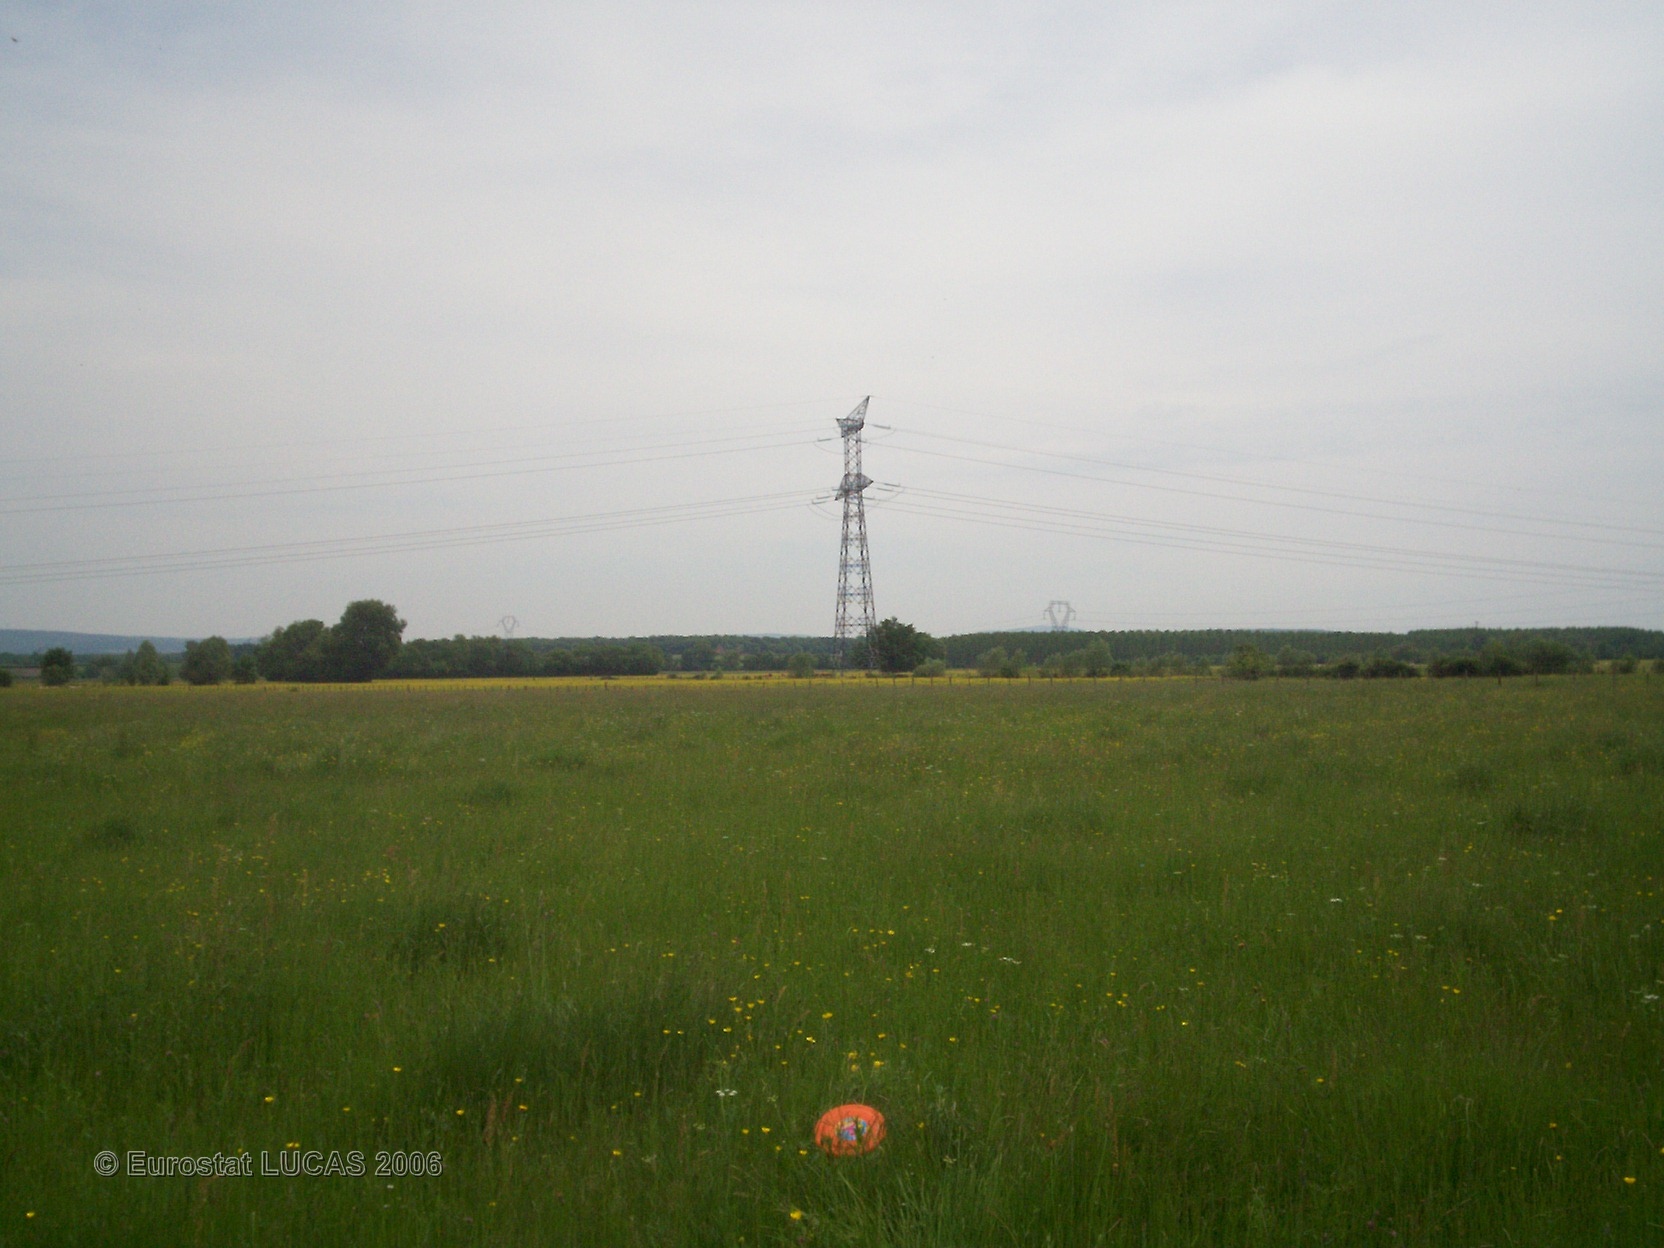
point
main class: Grassland
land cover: Grassland without tree/shrub cover
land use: Agriculture (excluding fallow land and kitchen gardens)
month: May
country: FR
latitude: 46.6367
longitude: 4.7370
